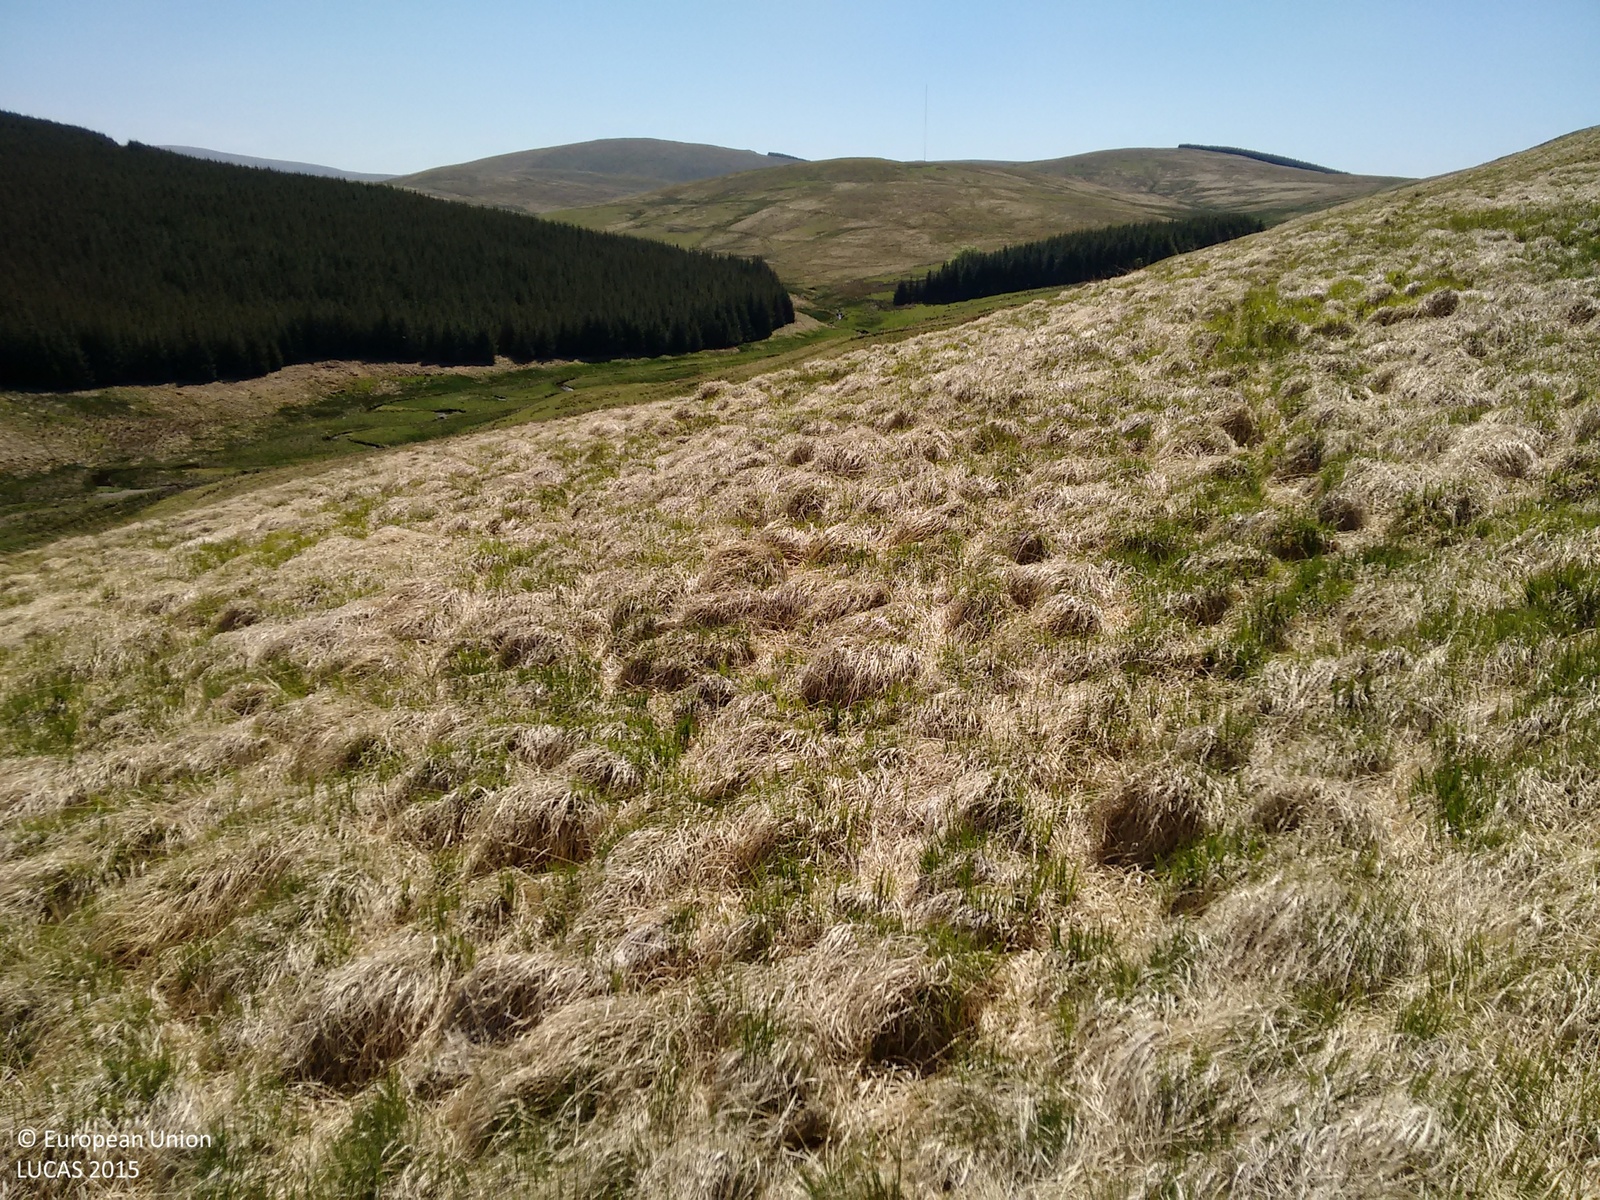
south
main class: Grassland
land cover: Grassland without tree/shrub cover
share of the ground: > 75 %
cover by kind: herbaceous plants 100 %
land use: Semi-natural and natural areas not in use
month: June
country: GB
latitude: 55.4723
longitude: -3.4779
